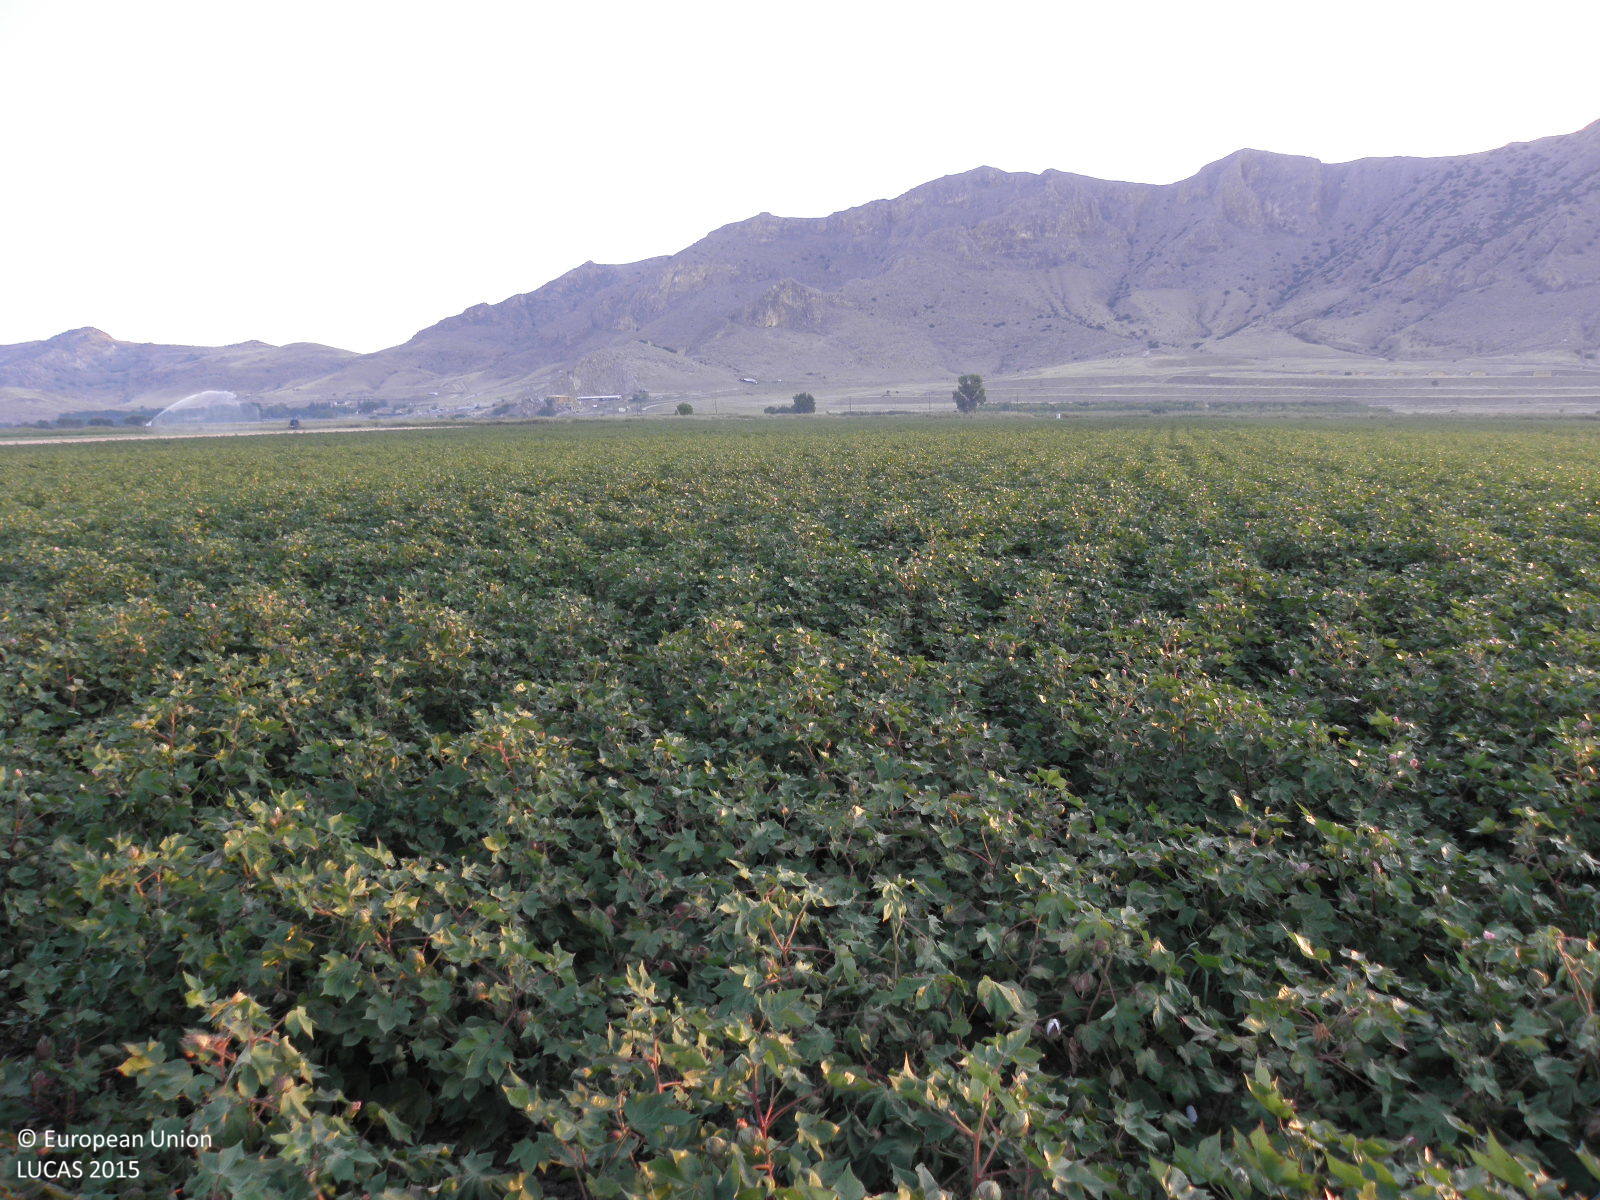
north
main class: Cropland
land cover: Cotton
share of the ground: > 75 %
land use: Agriculture (excluding fallow land and kitchen gardens)
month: September
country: GR
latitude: 39.6807
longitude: 22.5249
